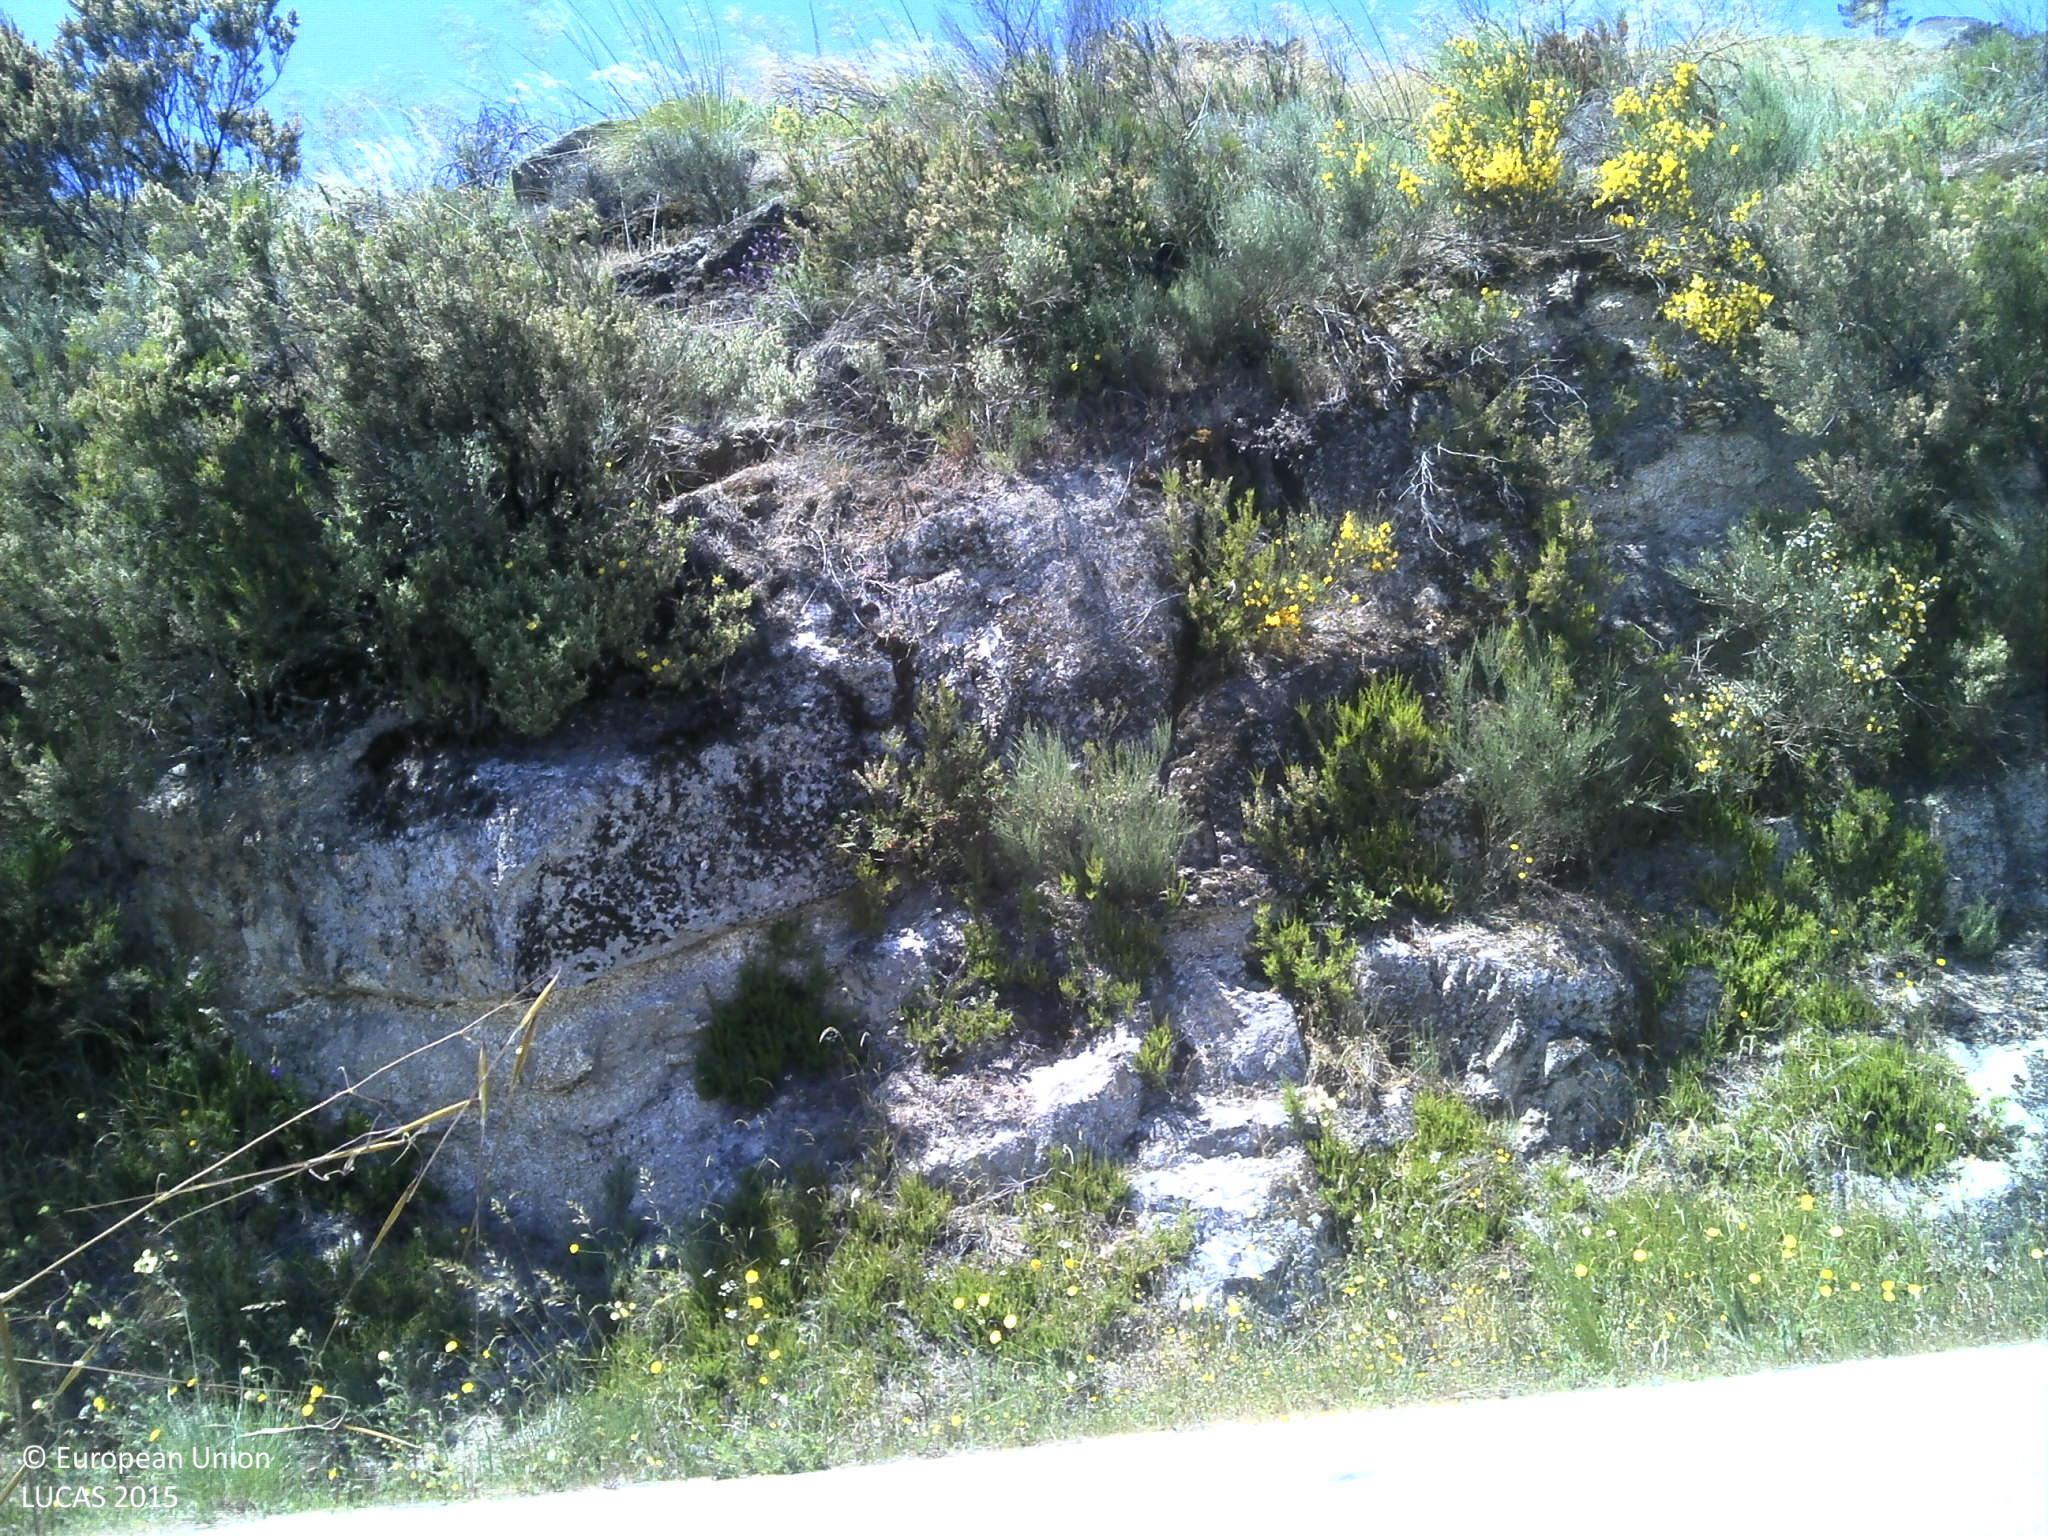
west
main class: Shrubland
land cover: Shrubland without tree cover
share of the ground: 50 - 75 %
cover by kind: shrubs 75 %, unconsolidated bare surface 20 %, herbaceous plants 5 %
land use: Semi-natural and natural areas not in use
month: May
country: PT
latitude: 40.4634
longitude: -7.3364
